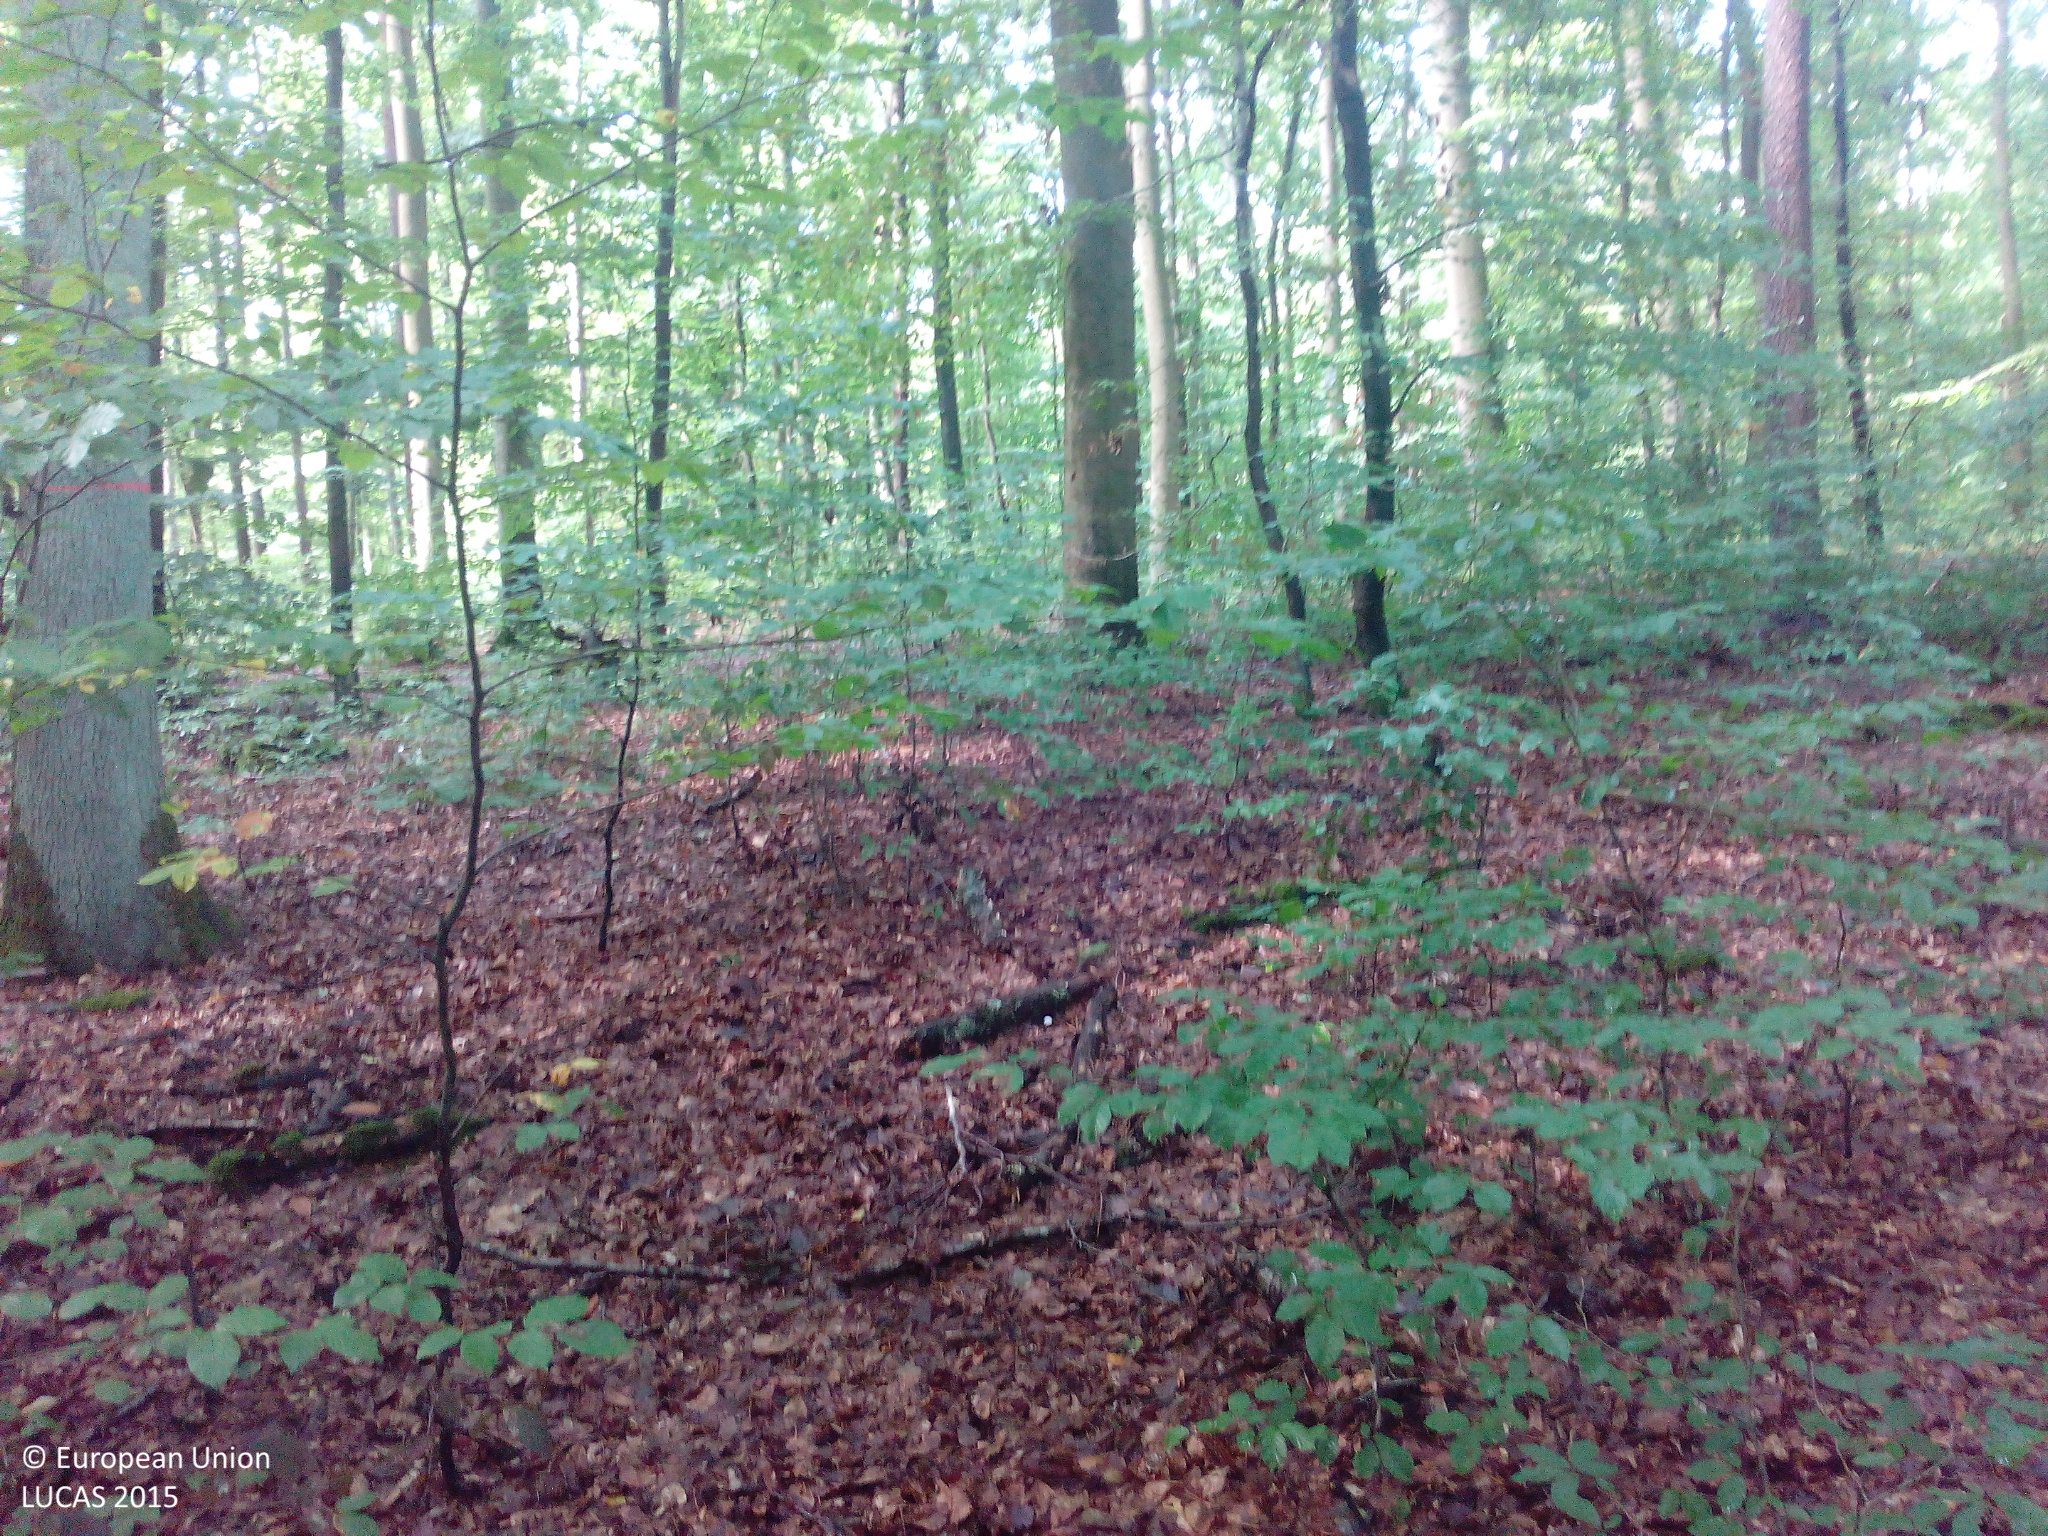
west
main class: Woodland
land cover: Broadleaved woodland
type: beech forest
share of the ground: > 75 %
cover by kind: broadleaved forest trees 85 %, coniferous forest trees 10 %, unconsolidated bare surface 5 %
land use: Forestry
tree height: > 5 m
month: September
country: DE
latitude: 49.8965
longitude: 9.9304
